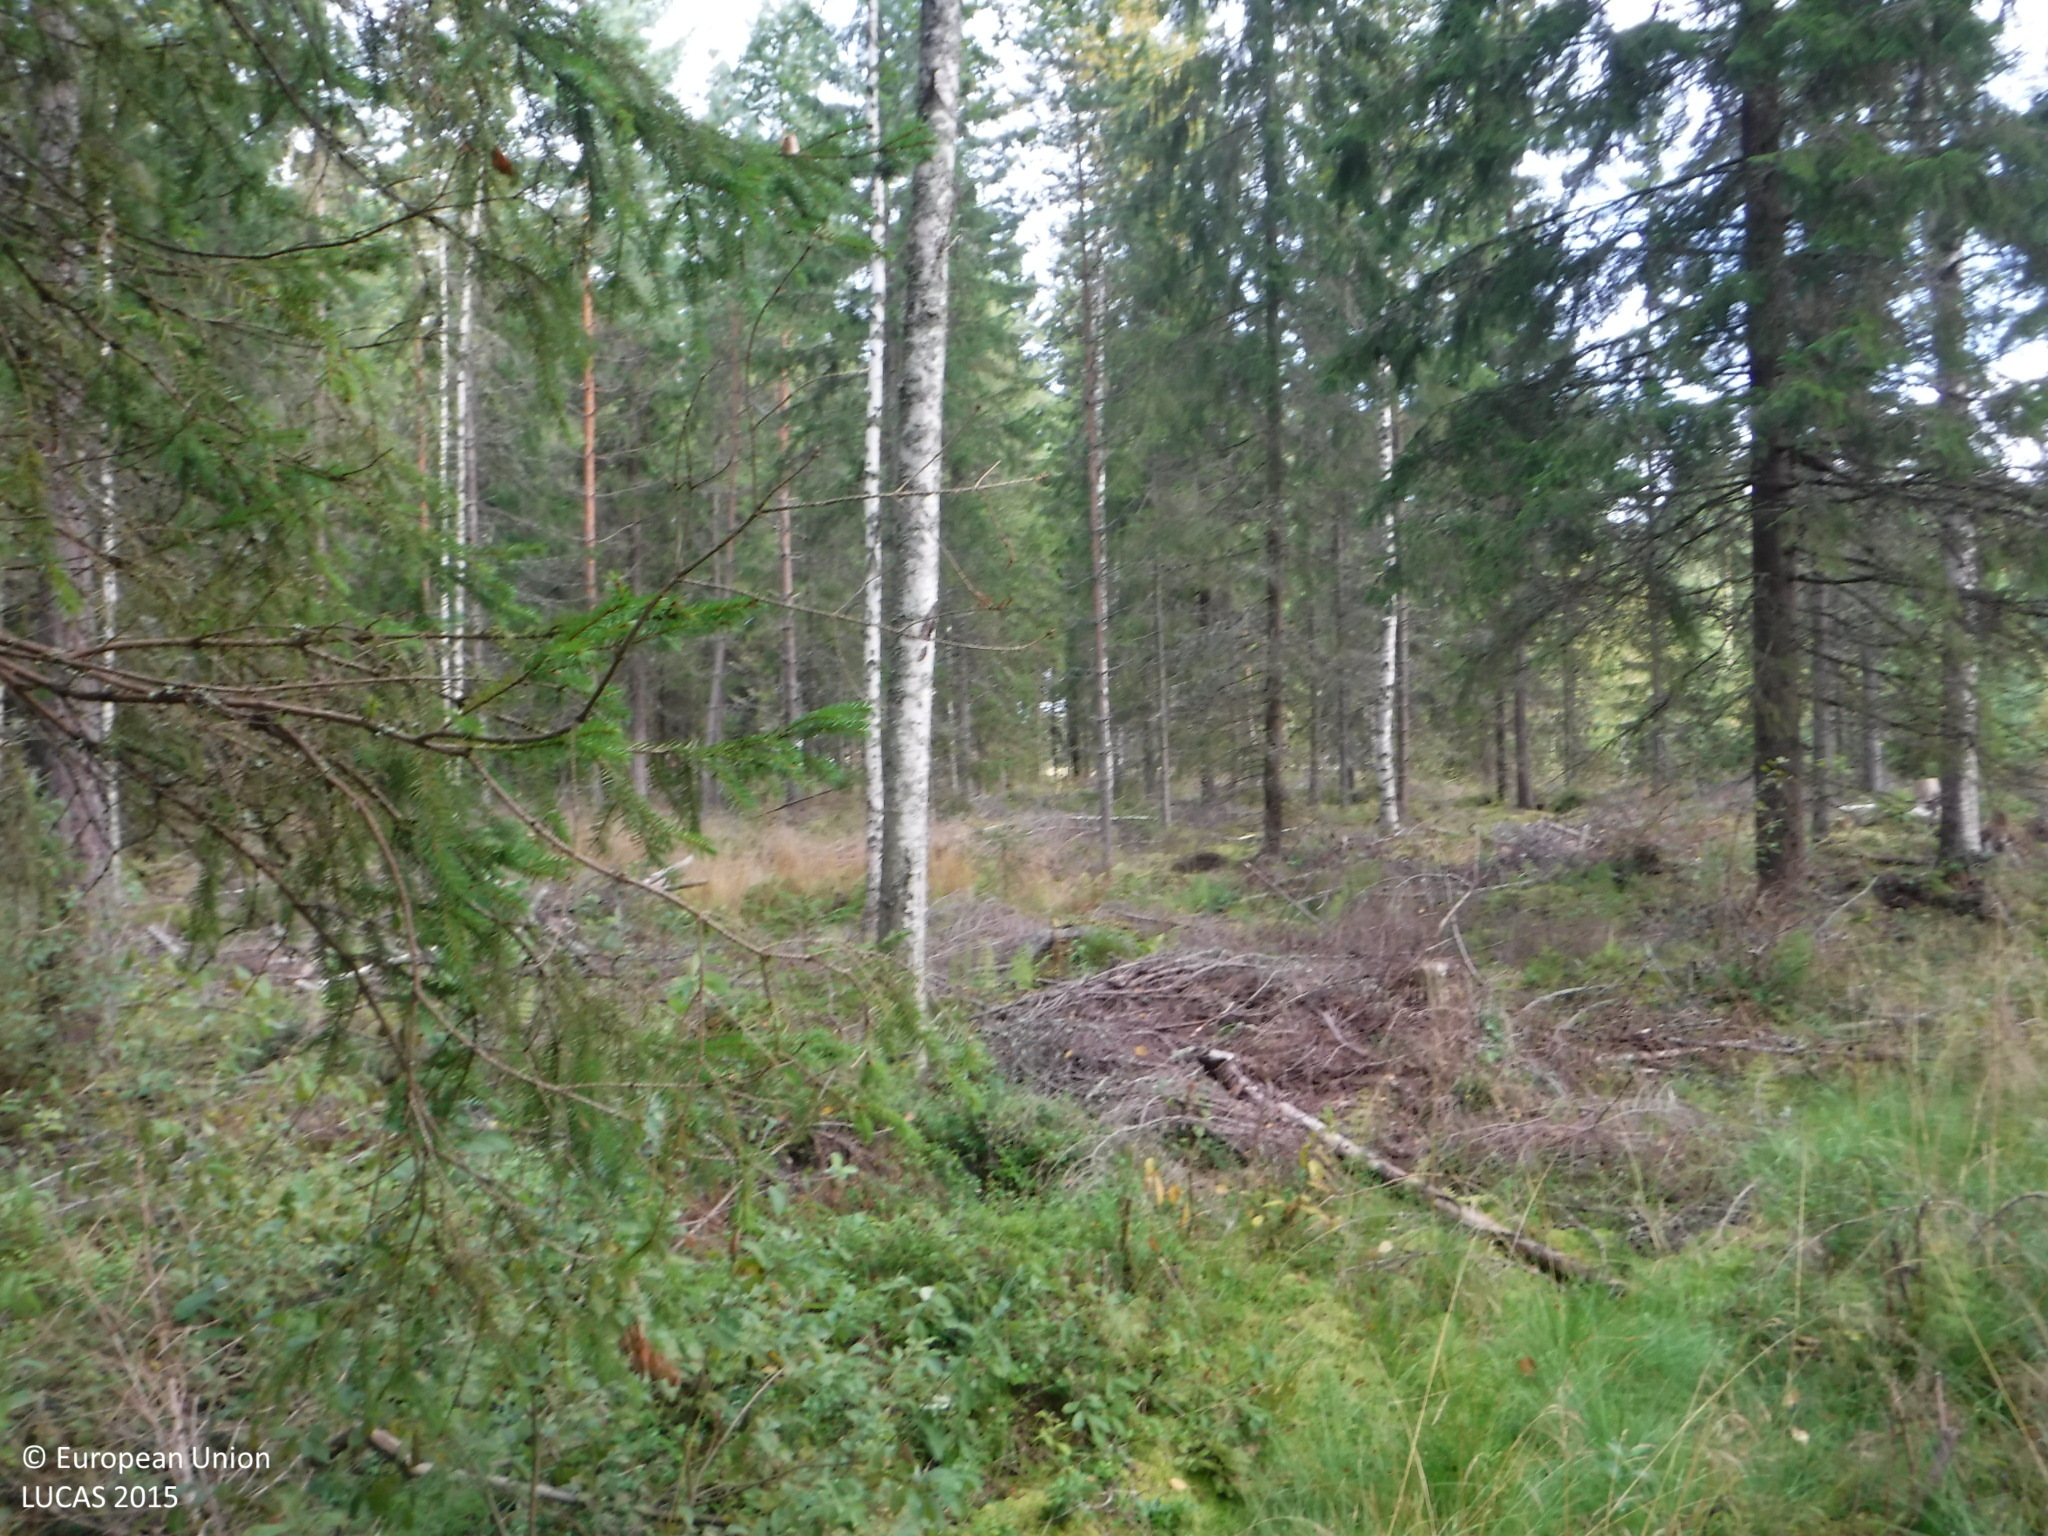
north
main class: Woodland
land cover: Other mixed woodland
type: boreal forest
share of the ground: 25 - 50 %
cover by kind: herbaceous plants 40 %, coniferous forest trees 25 %, shrubs 20 %, broadleaved forest trees 15 %
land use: Forestry
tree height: > 5 m
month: September
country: FI
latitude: 61.3575
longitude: 22.5008
